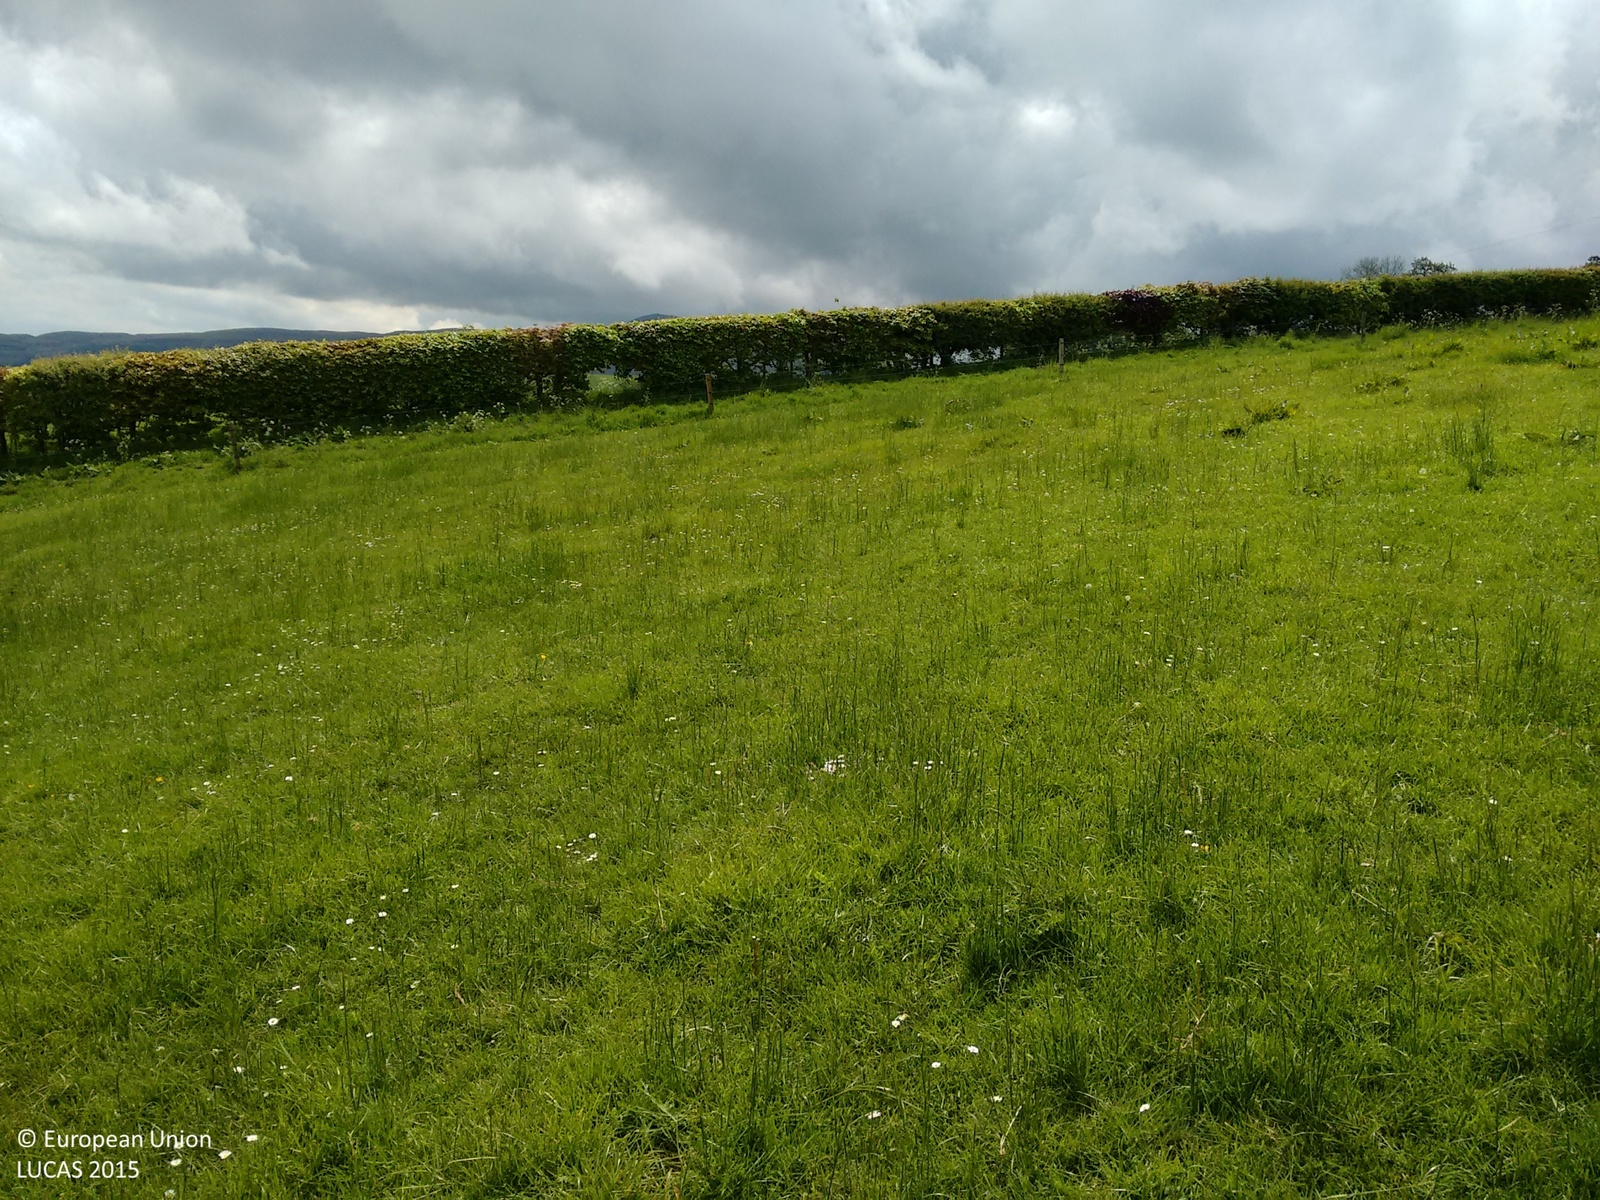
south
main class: Grassland
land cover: Grassland without tree/shrub cover
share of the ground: > 75 %
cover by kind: herbaceous plants 100 %
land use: Agriculture (excluding fallow land and kitchen gardens)
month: June
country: GB
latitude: 56.2939
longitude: -3.3054
